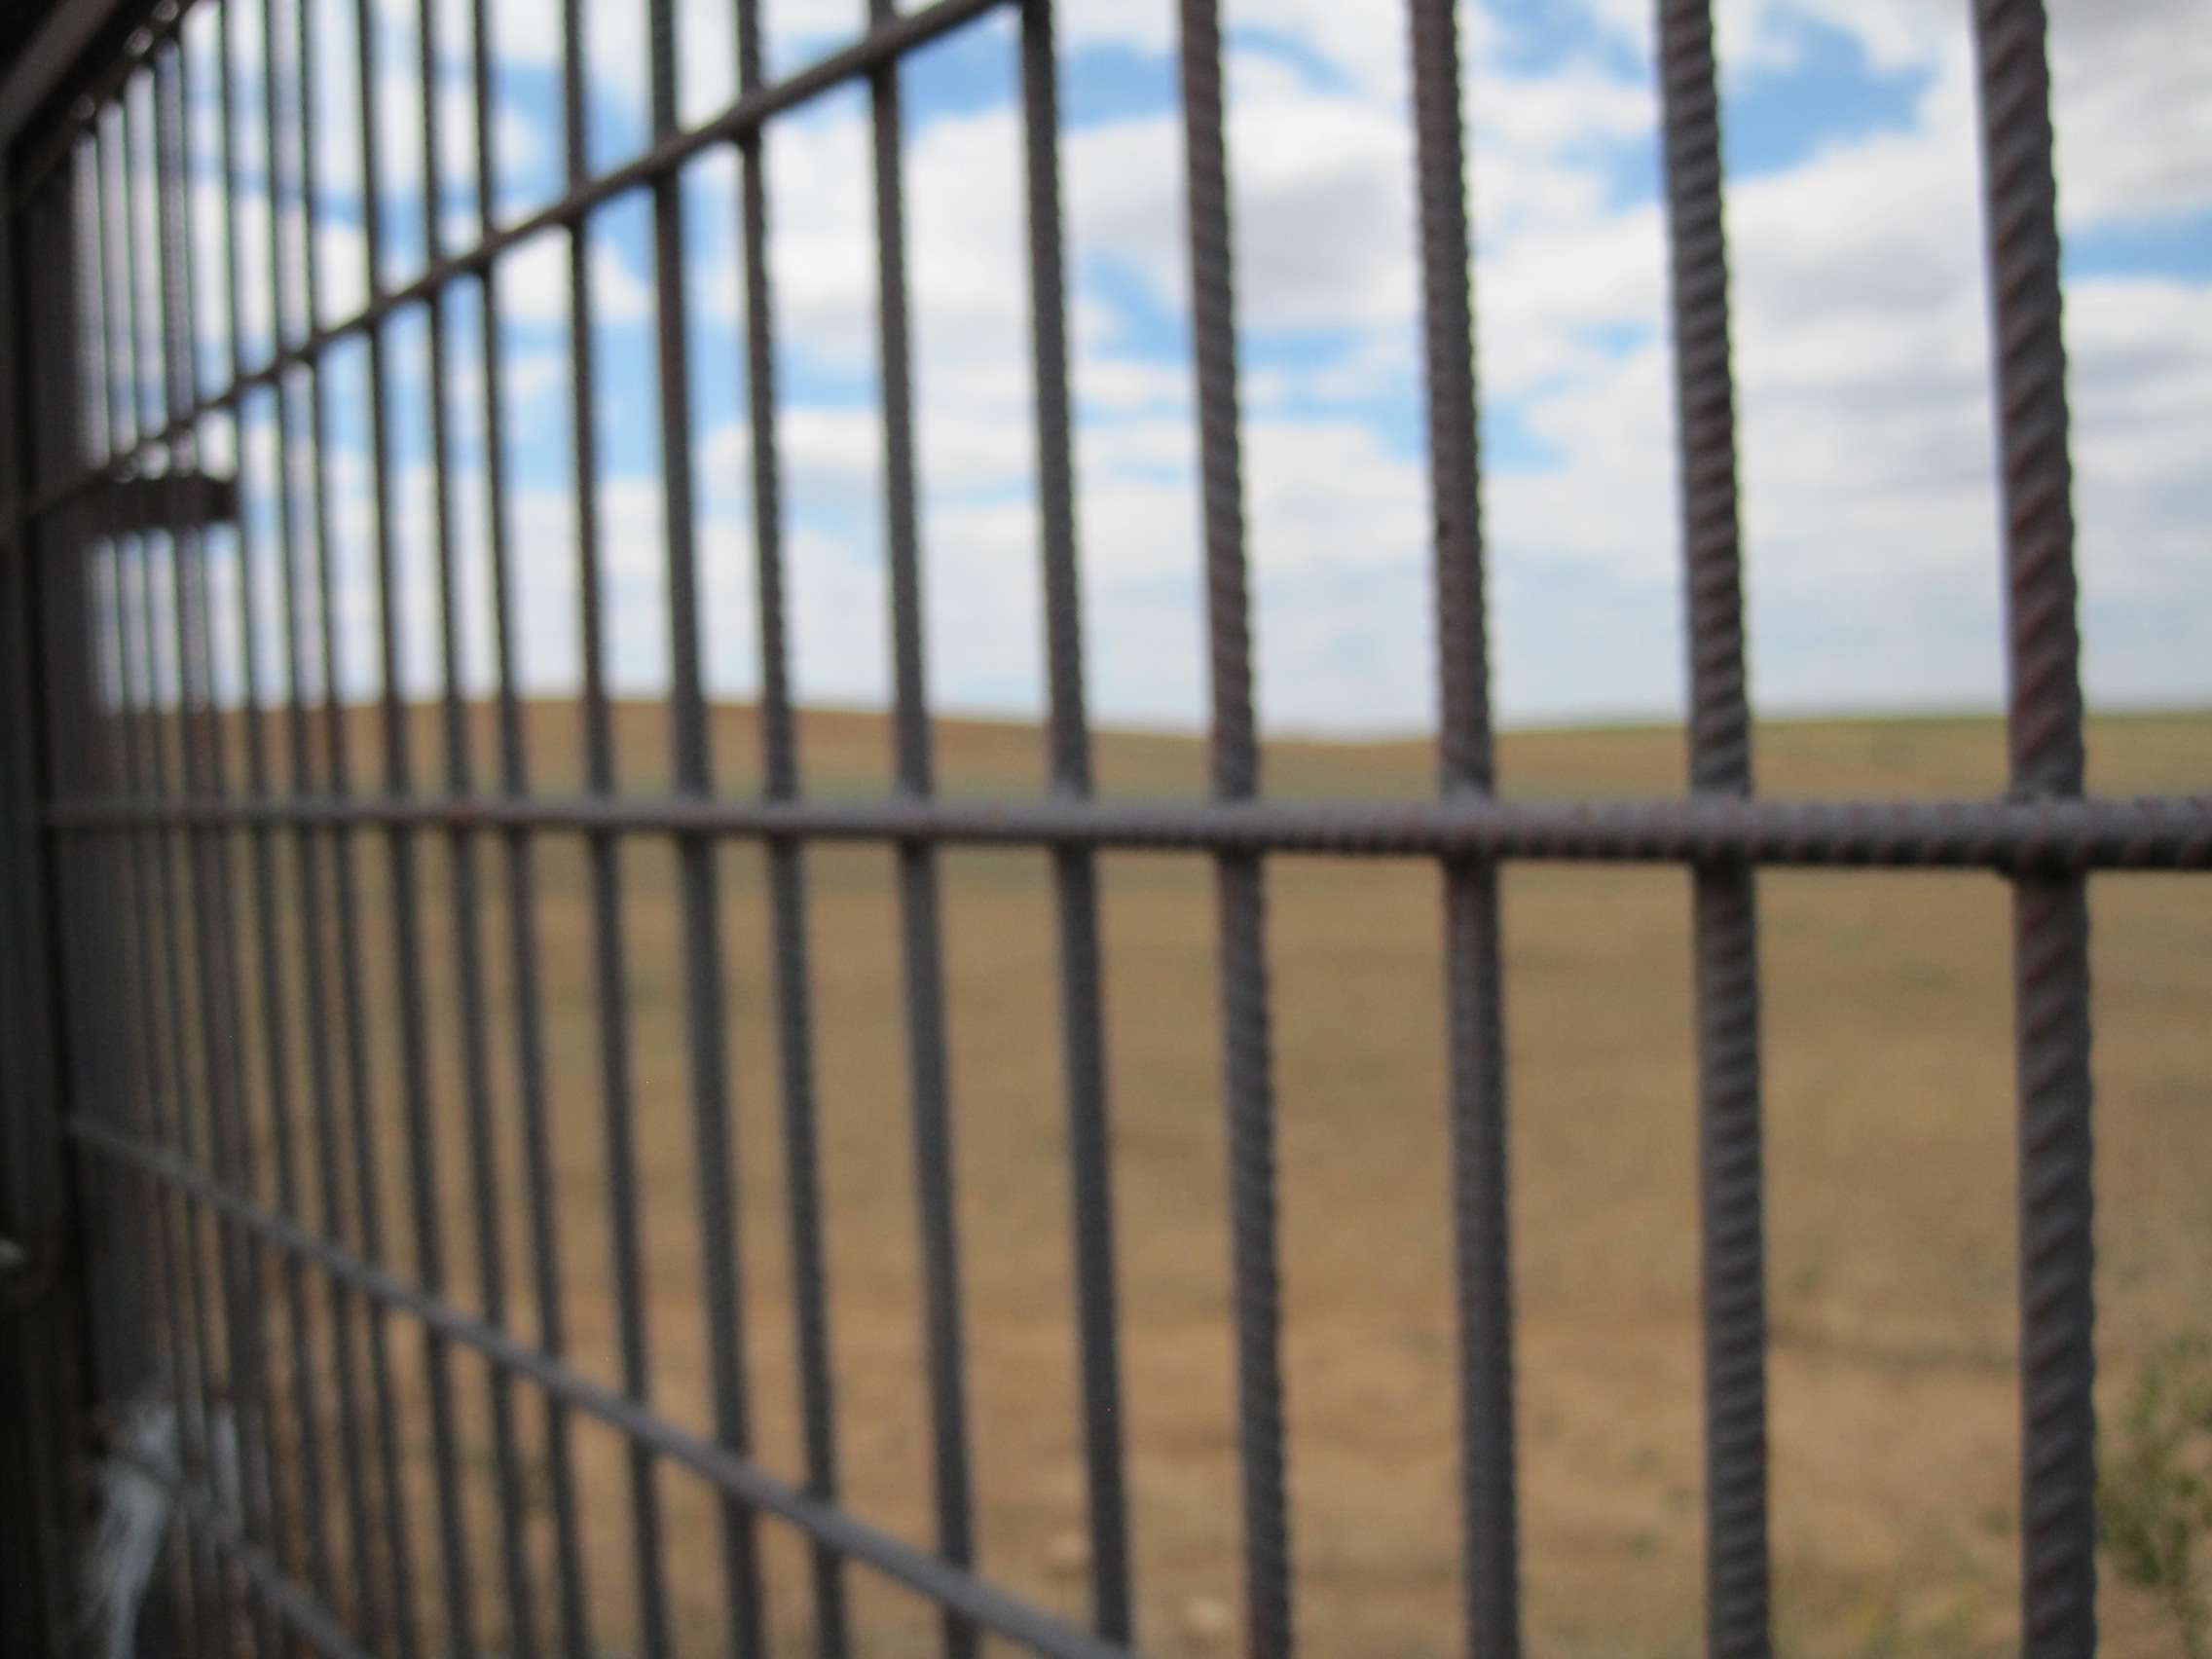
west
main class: Woodland
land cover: Broadleaved woodland
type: floodplain forest
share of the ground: > 75 %
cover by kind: broadleaved forest trees 80 %, herbaceous plants 20 %
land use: Forestry
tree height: > 5 m
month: July
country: ES
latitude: 42.0830
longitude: -5.5761
